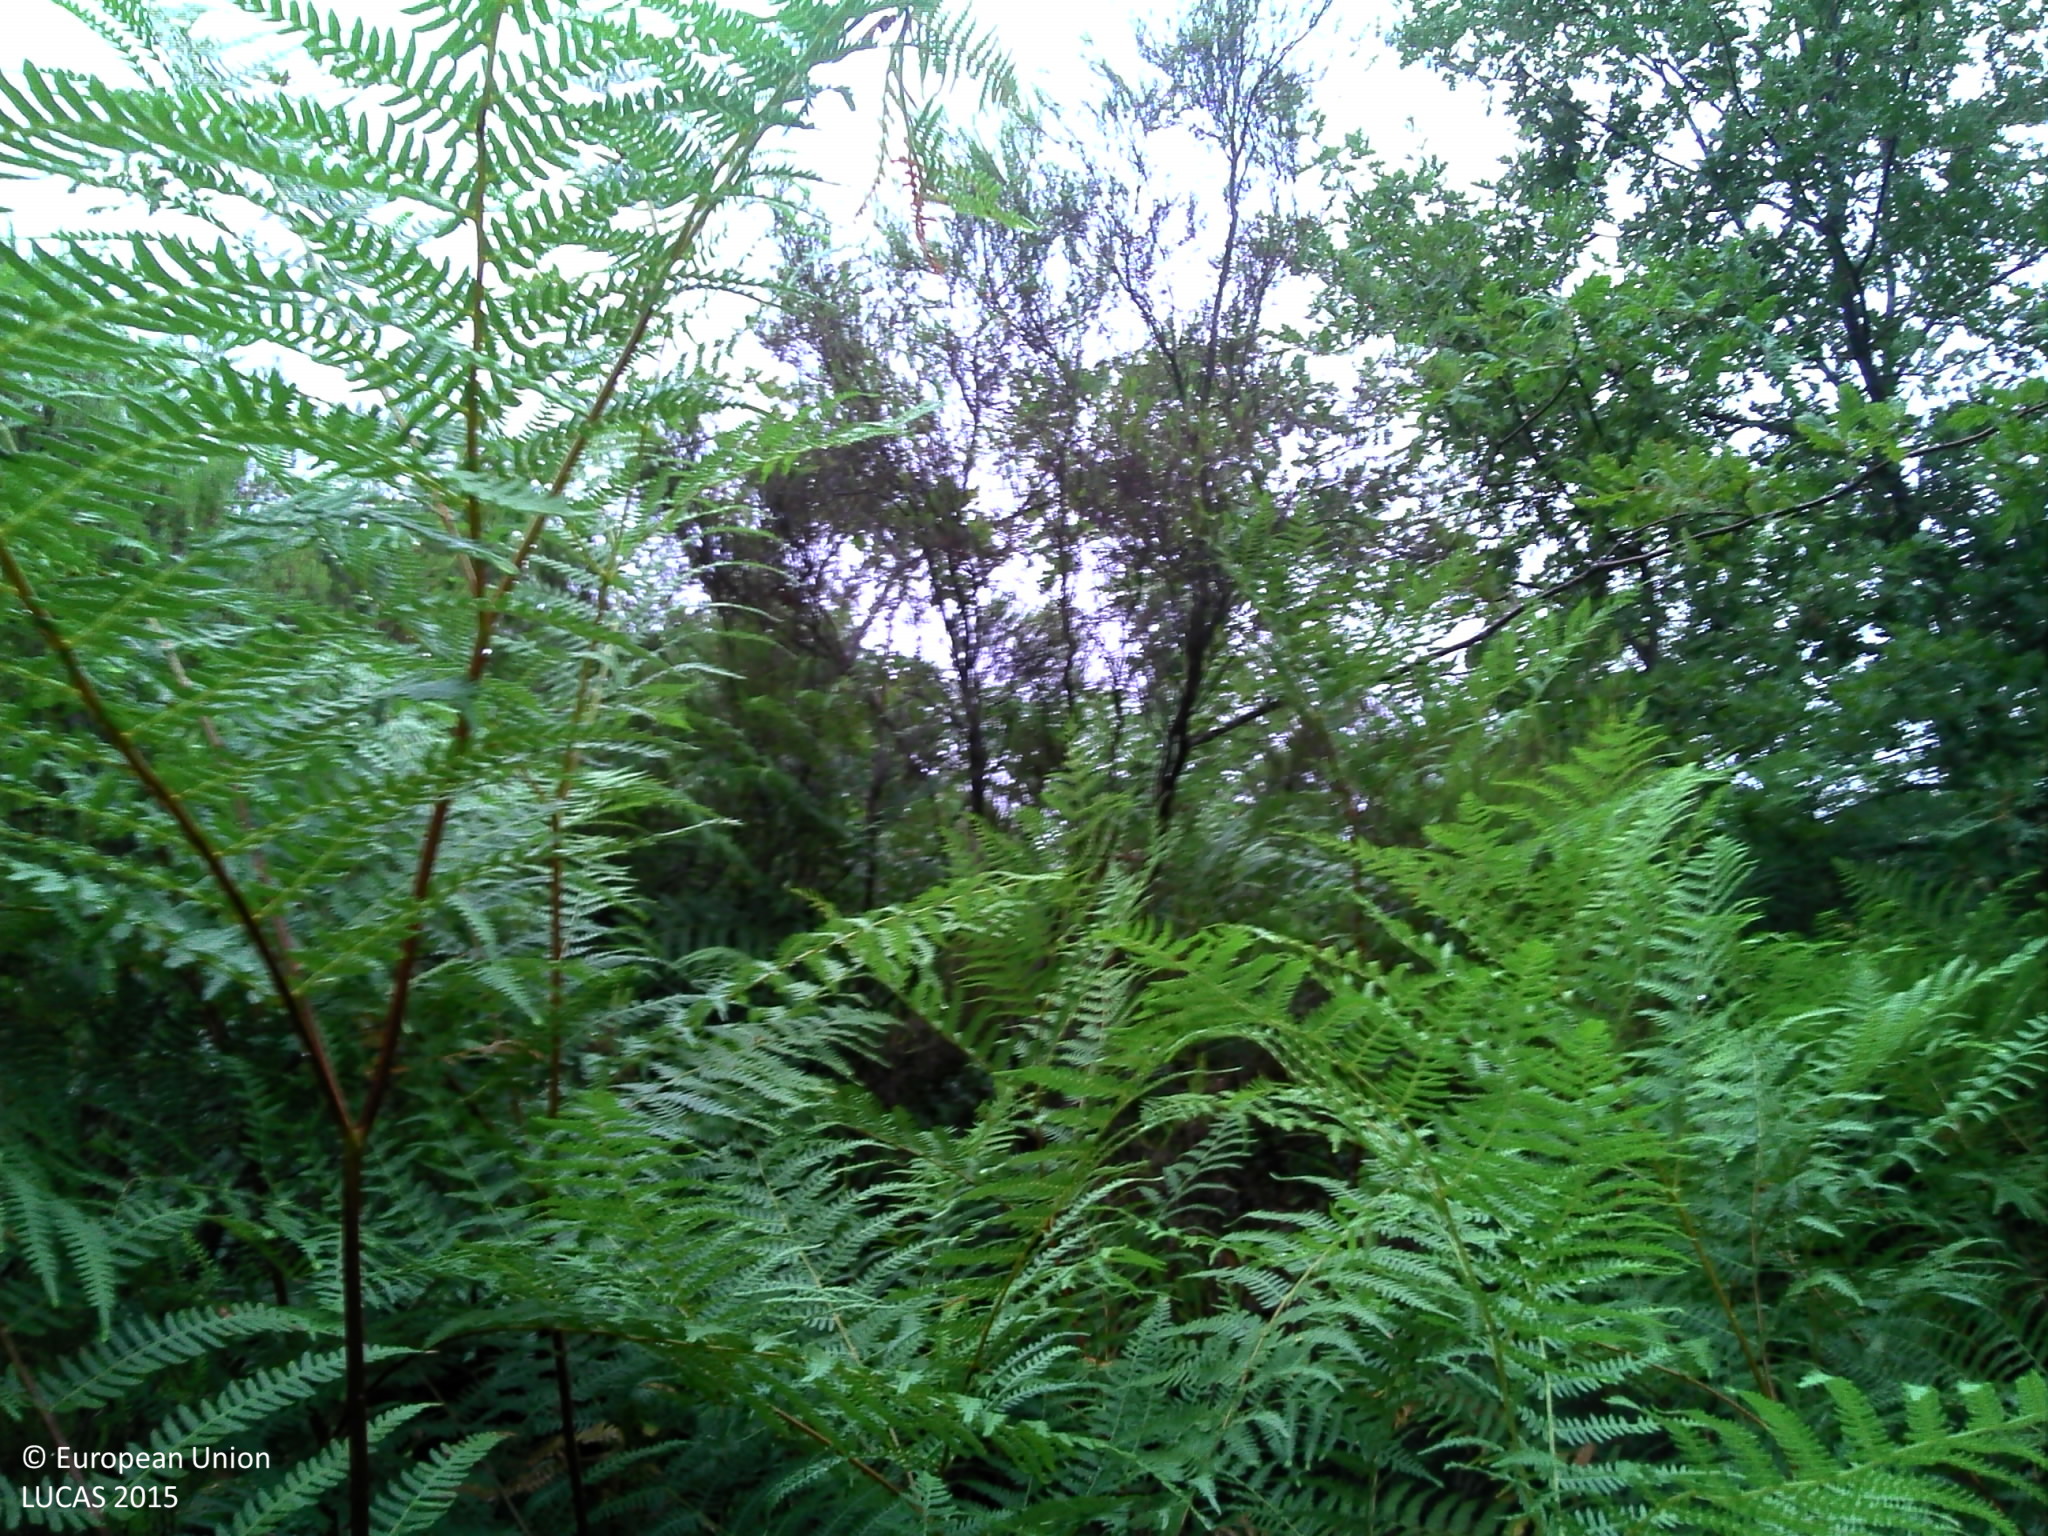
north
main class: Woodland
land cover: Broadleaved woodland
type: thermophilous deciduous forest
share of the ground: > 75 %
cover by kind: broadleaved forest trees 80 %, herbaceous plants 10 %, shrubs 5 %, lichens and mosses 5 %
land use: Forestry
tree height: < 5 m
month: August
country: FR
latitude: 44.5995
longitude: 0.8602
